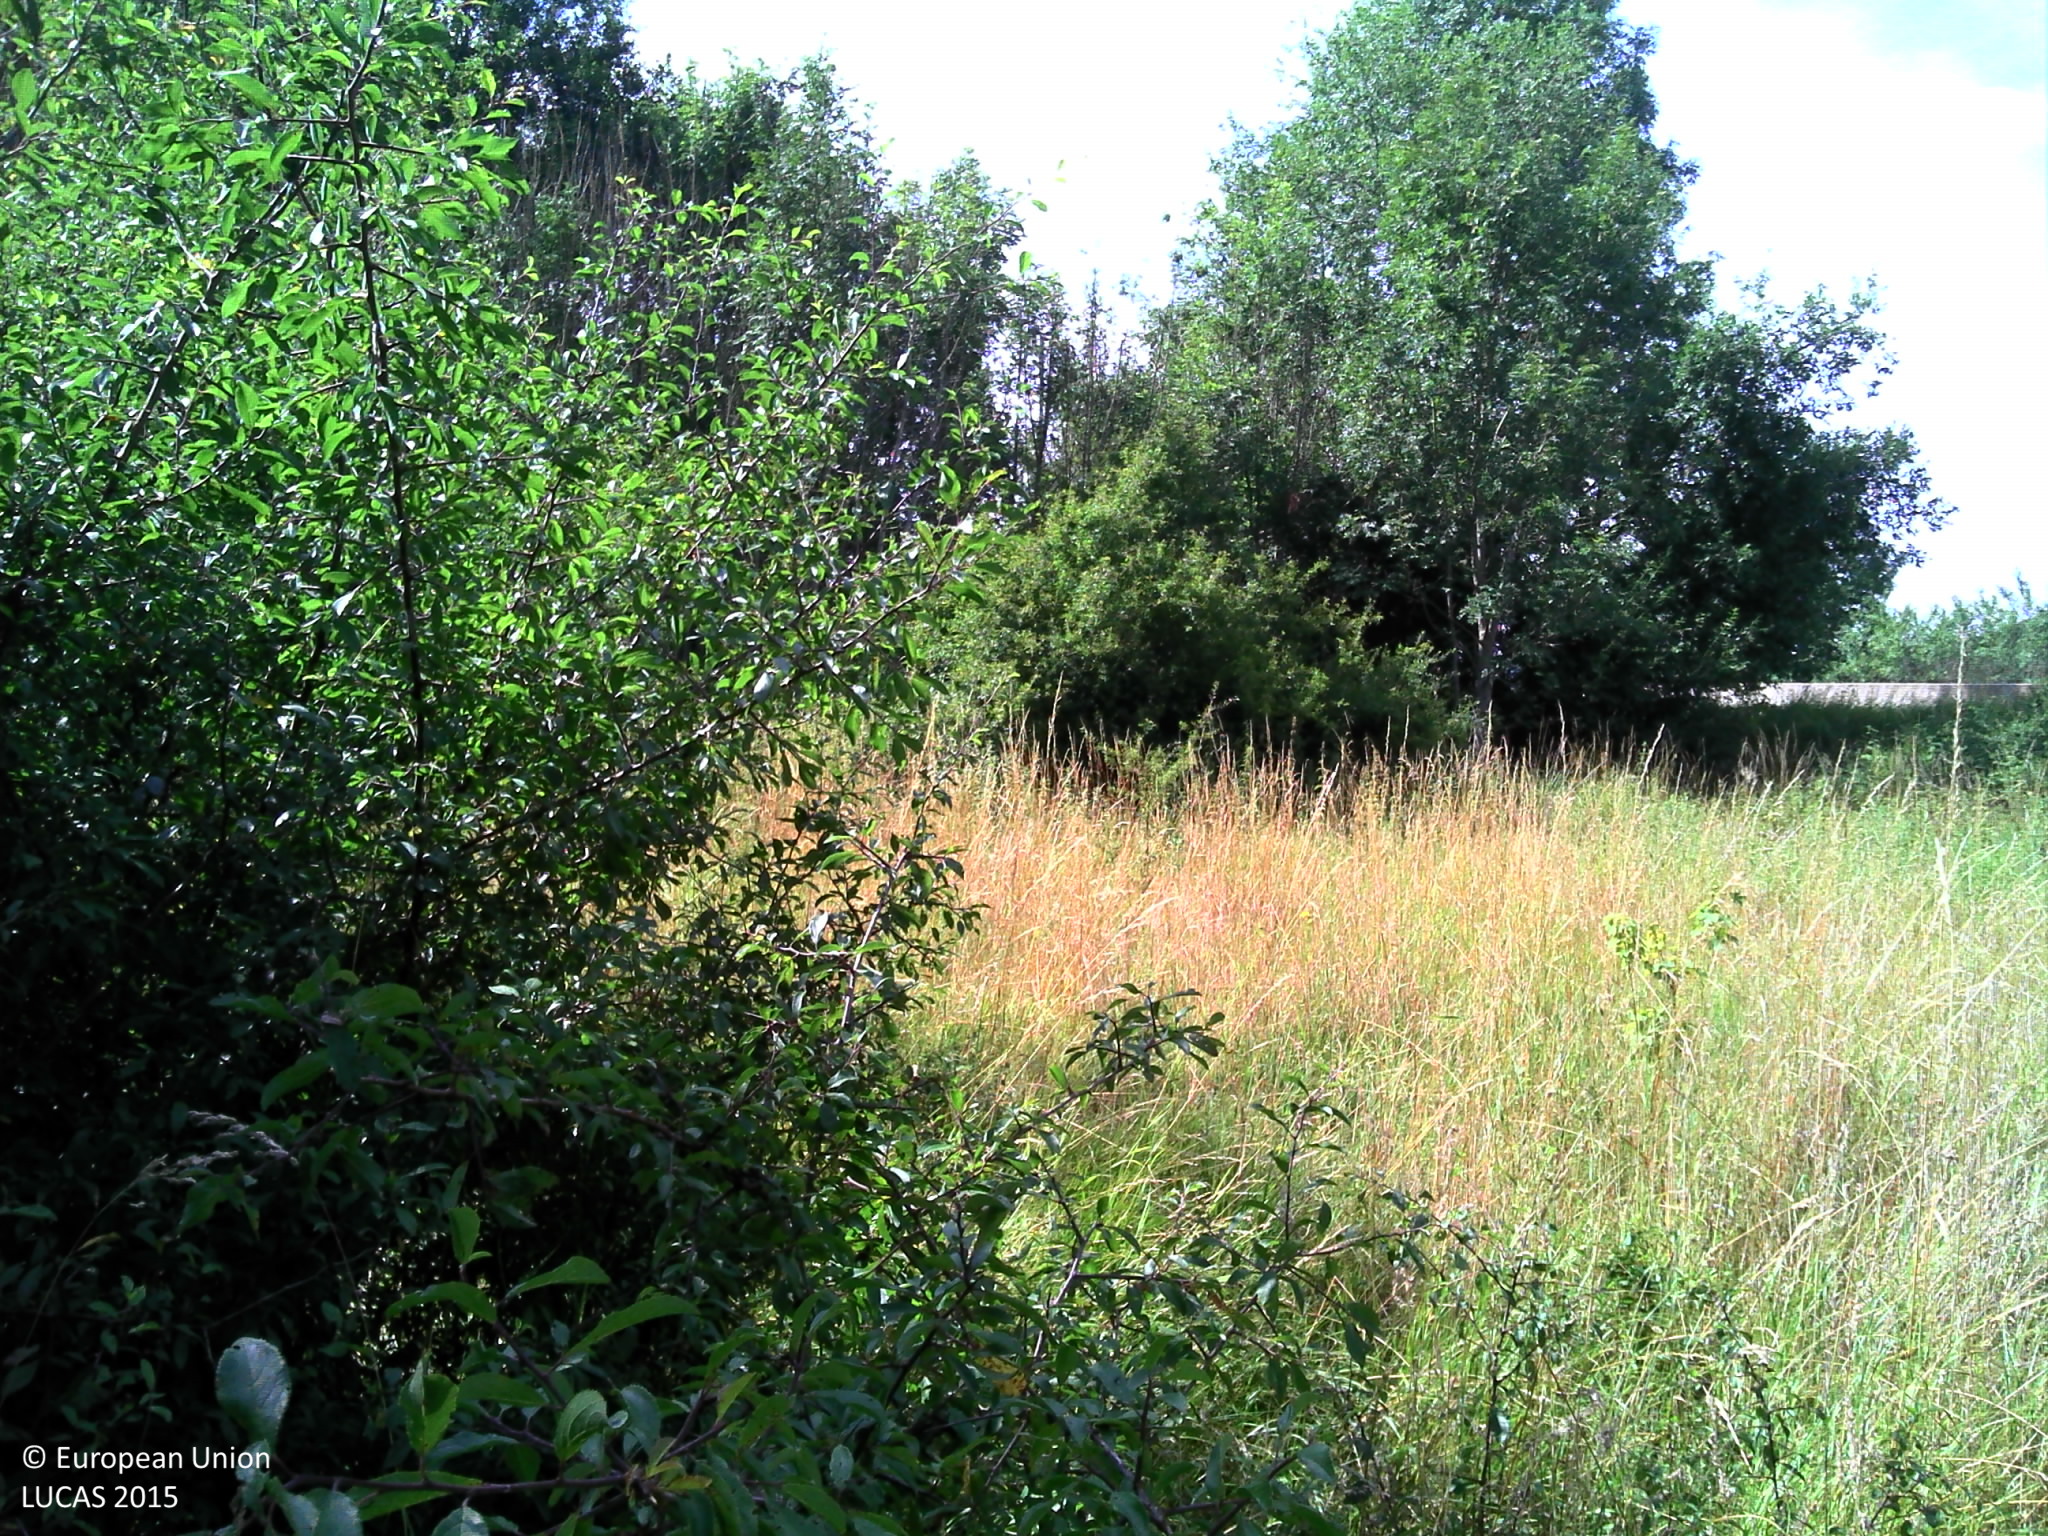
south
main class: Shrubland
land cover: Shrubland with sparse tree cover
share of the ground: 50 - 75 %
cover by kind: shrubs 60 %, herbaceous plants 35 %, broadleaved forest trees 5 %
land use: Forestry
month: July
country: BE
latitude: 49.7286
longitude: 5.7954
